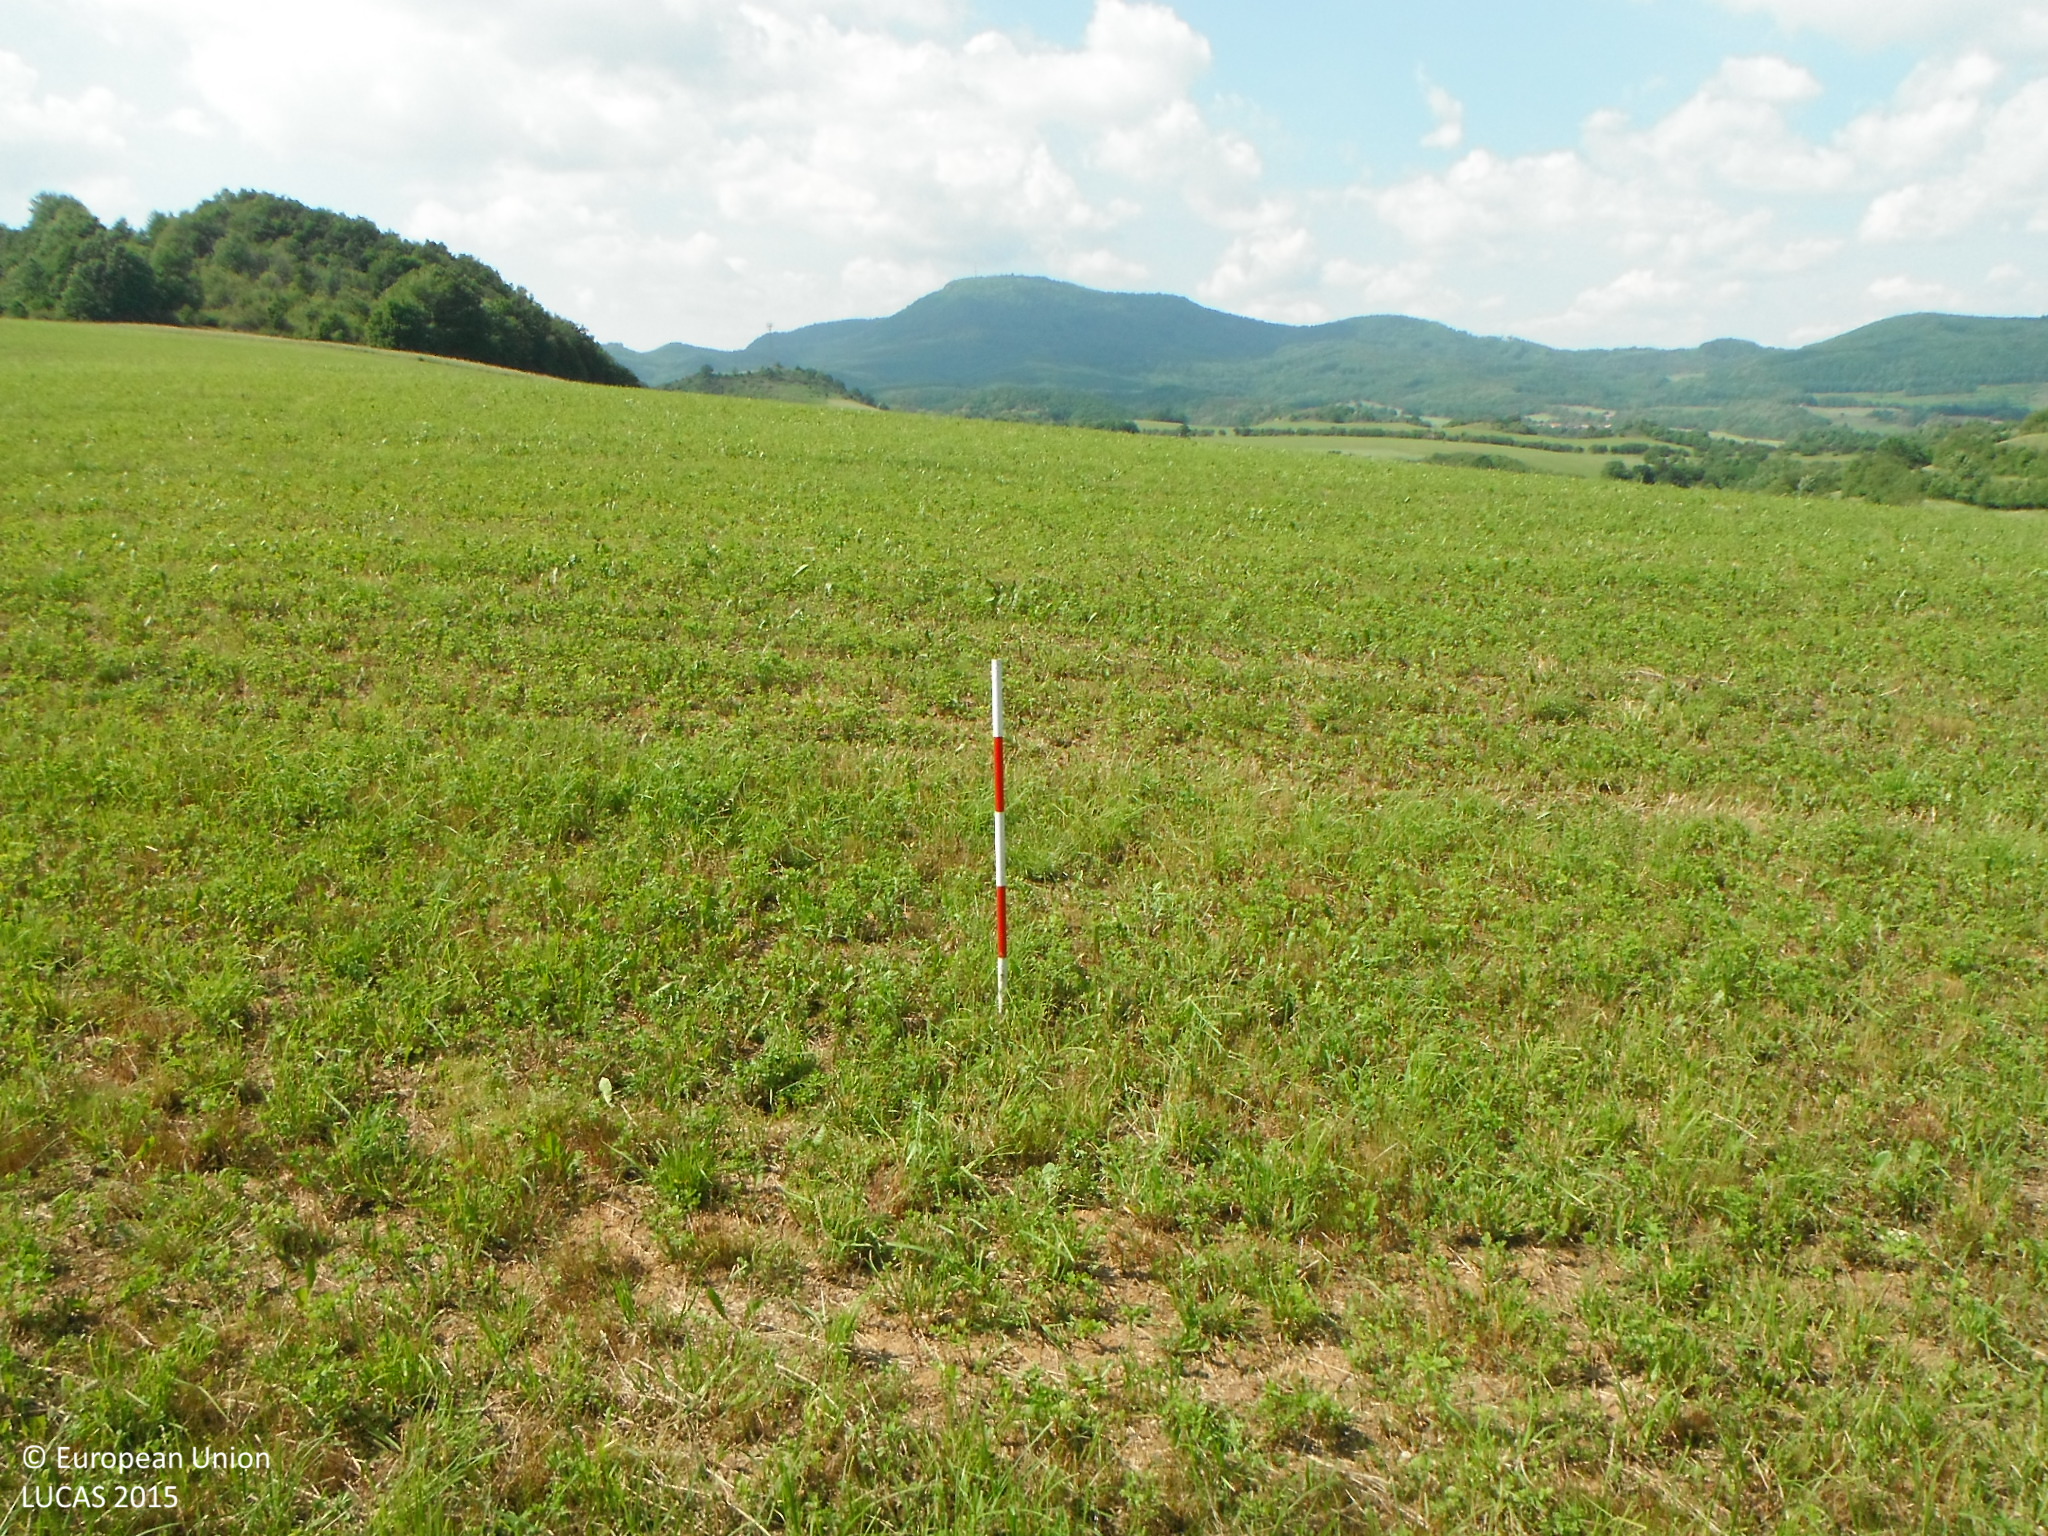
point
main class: Cropland
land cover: Other leguminous and mixtures for fodder
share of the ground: > 75 %
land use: Agriculture (excluding fallow land and kitchen gardens)
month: May
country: SK
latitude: 48.3507
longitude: 18.9122
